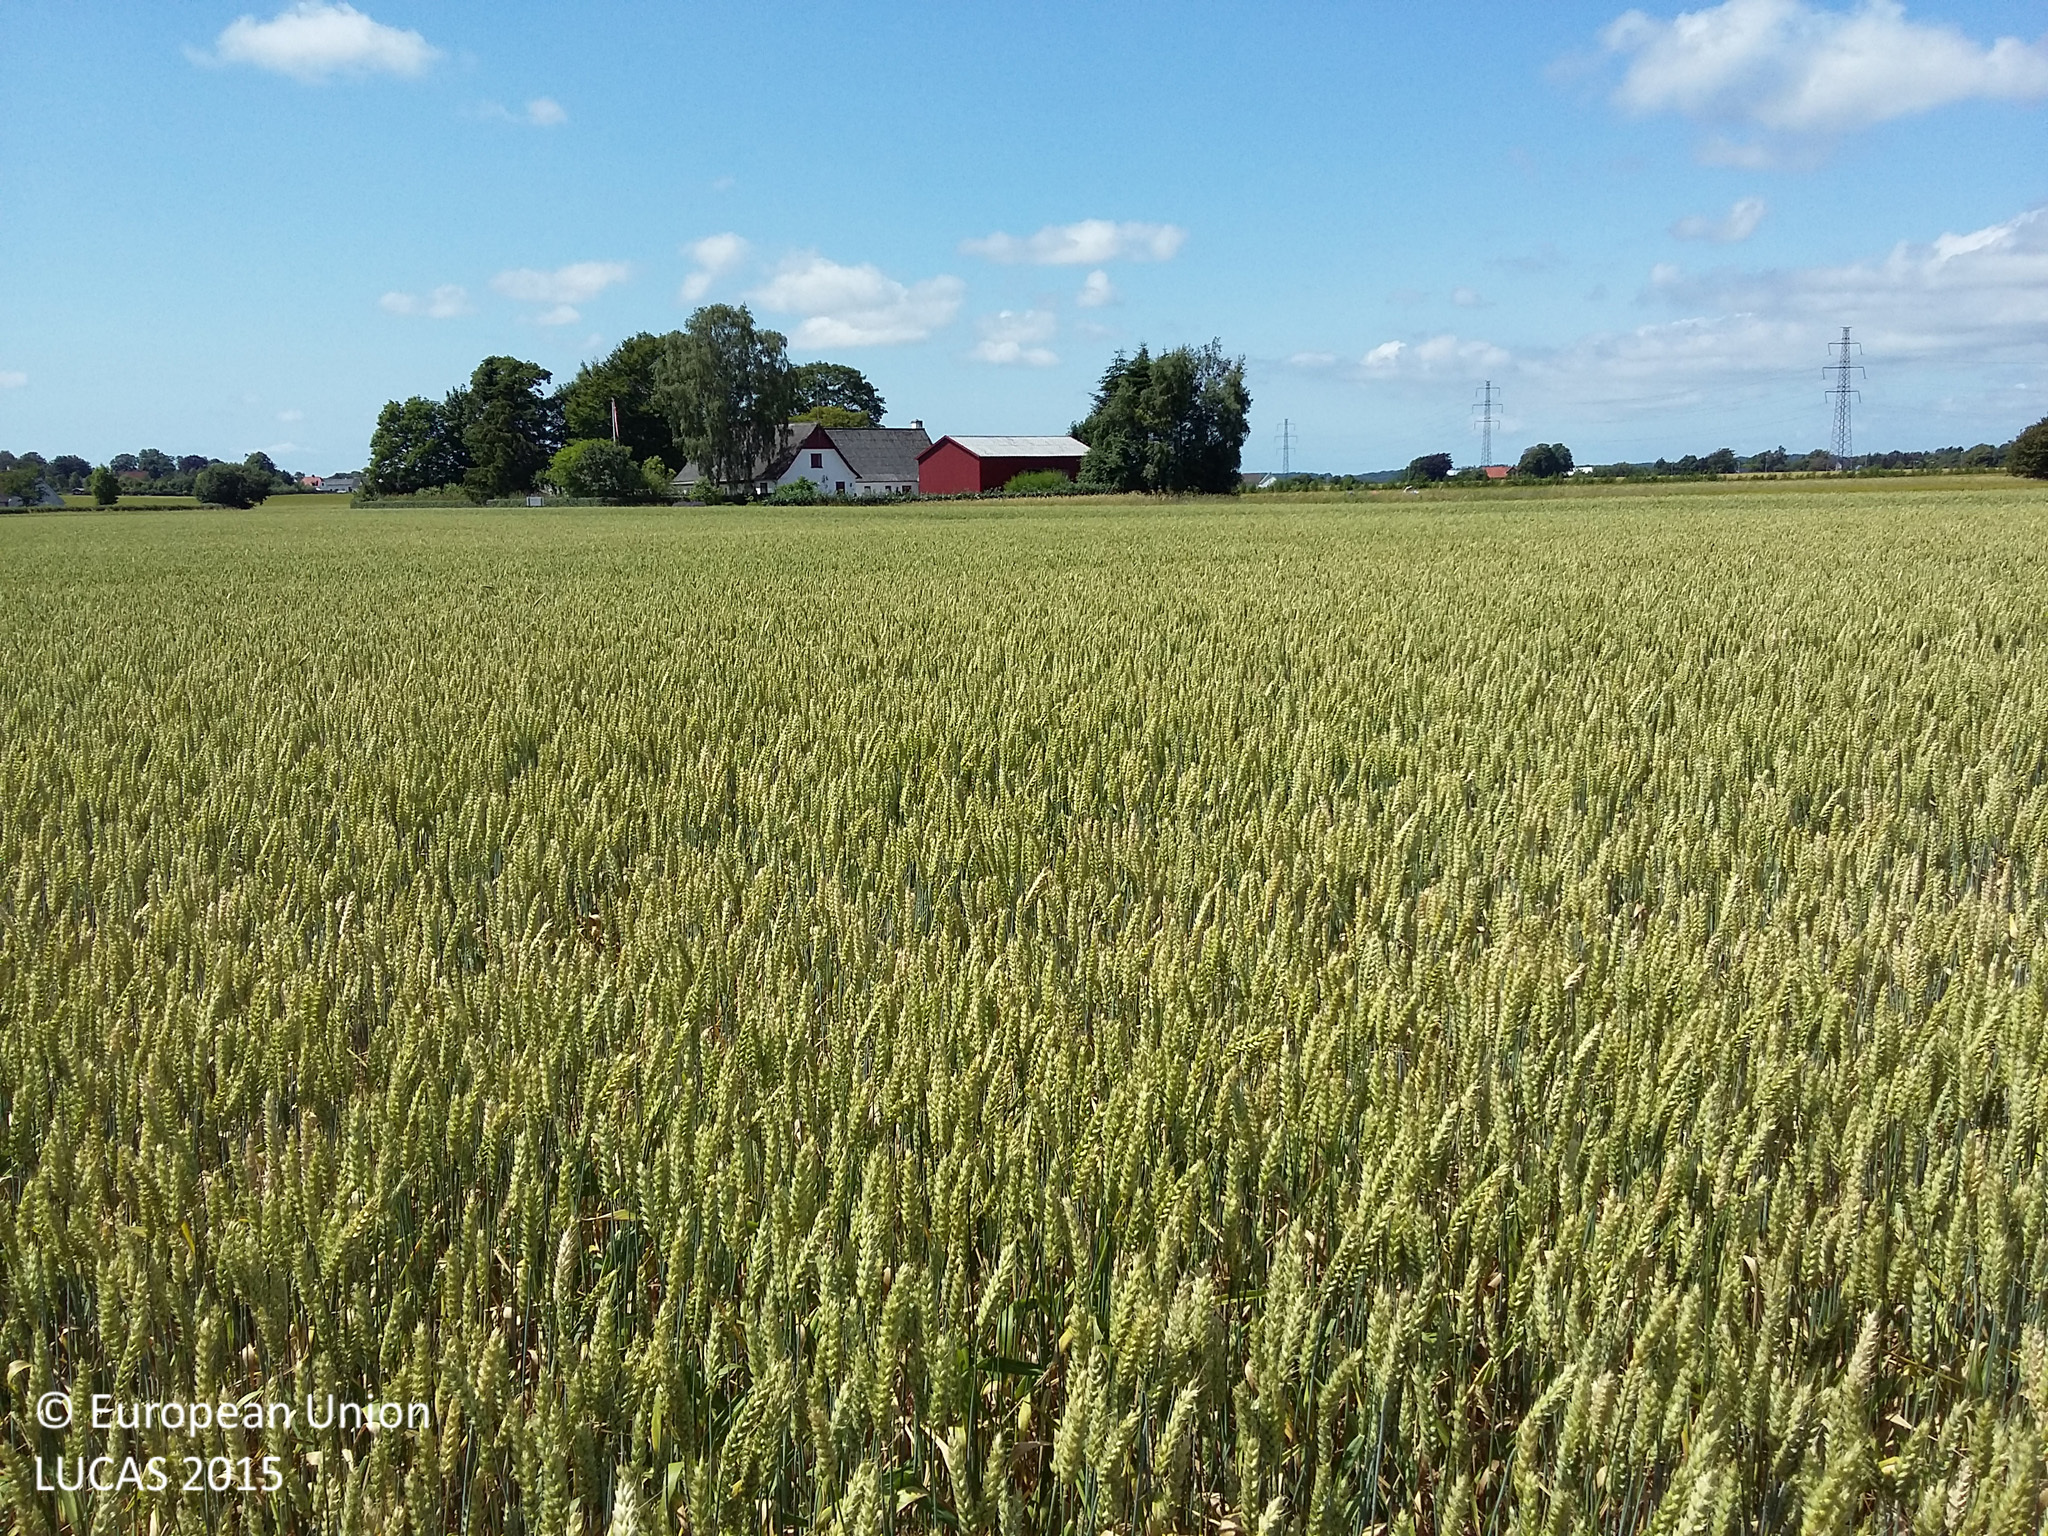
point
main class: Cropland
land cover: Common wheat
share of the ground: > 75 %
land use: Agriculture (excluding fallow land and kitchen gardens)
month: July
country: DK
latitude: 55.5138
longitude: 11.5031
